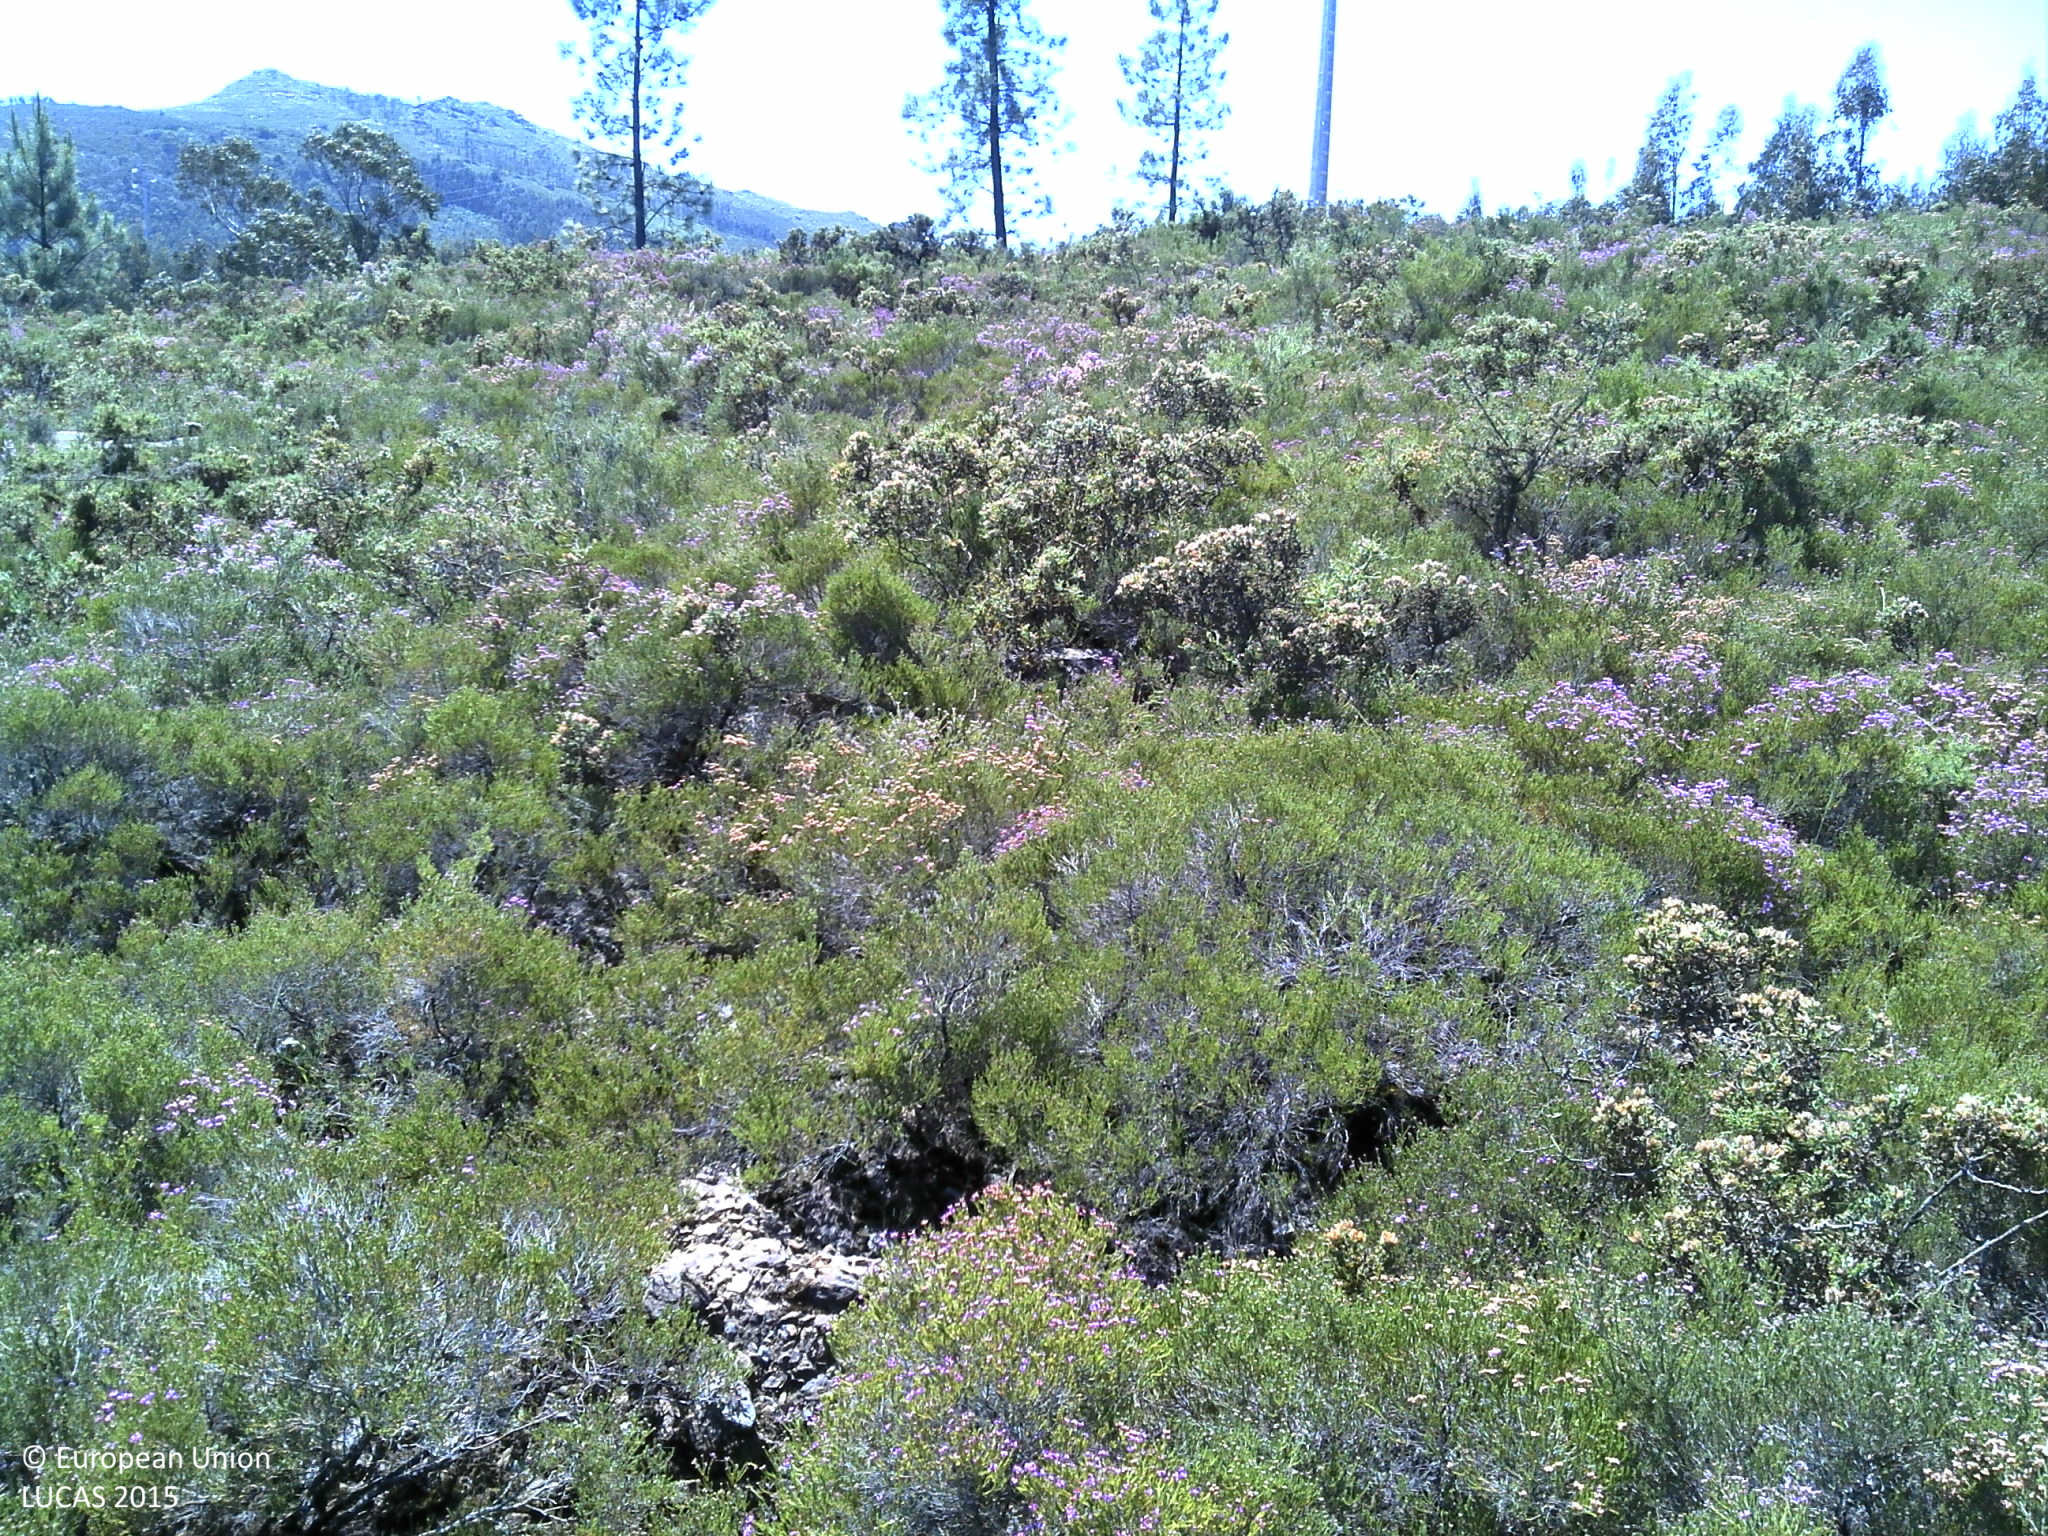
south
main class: Shrubland
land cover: Shrubland without tree cover
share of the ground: 50 - 75 %
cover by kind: shrubs 75 %, unconsolidated bare surface 20 %, herbaceous plants 5 %
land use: Semi-natural and natural areas not in use
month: May
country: PT
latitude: 41.8154
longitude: -8.6184
